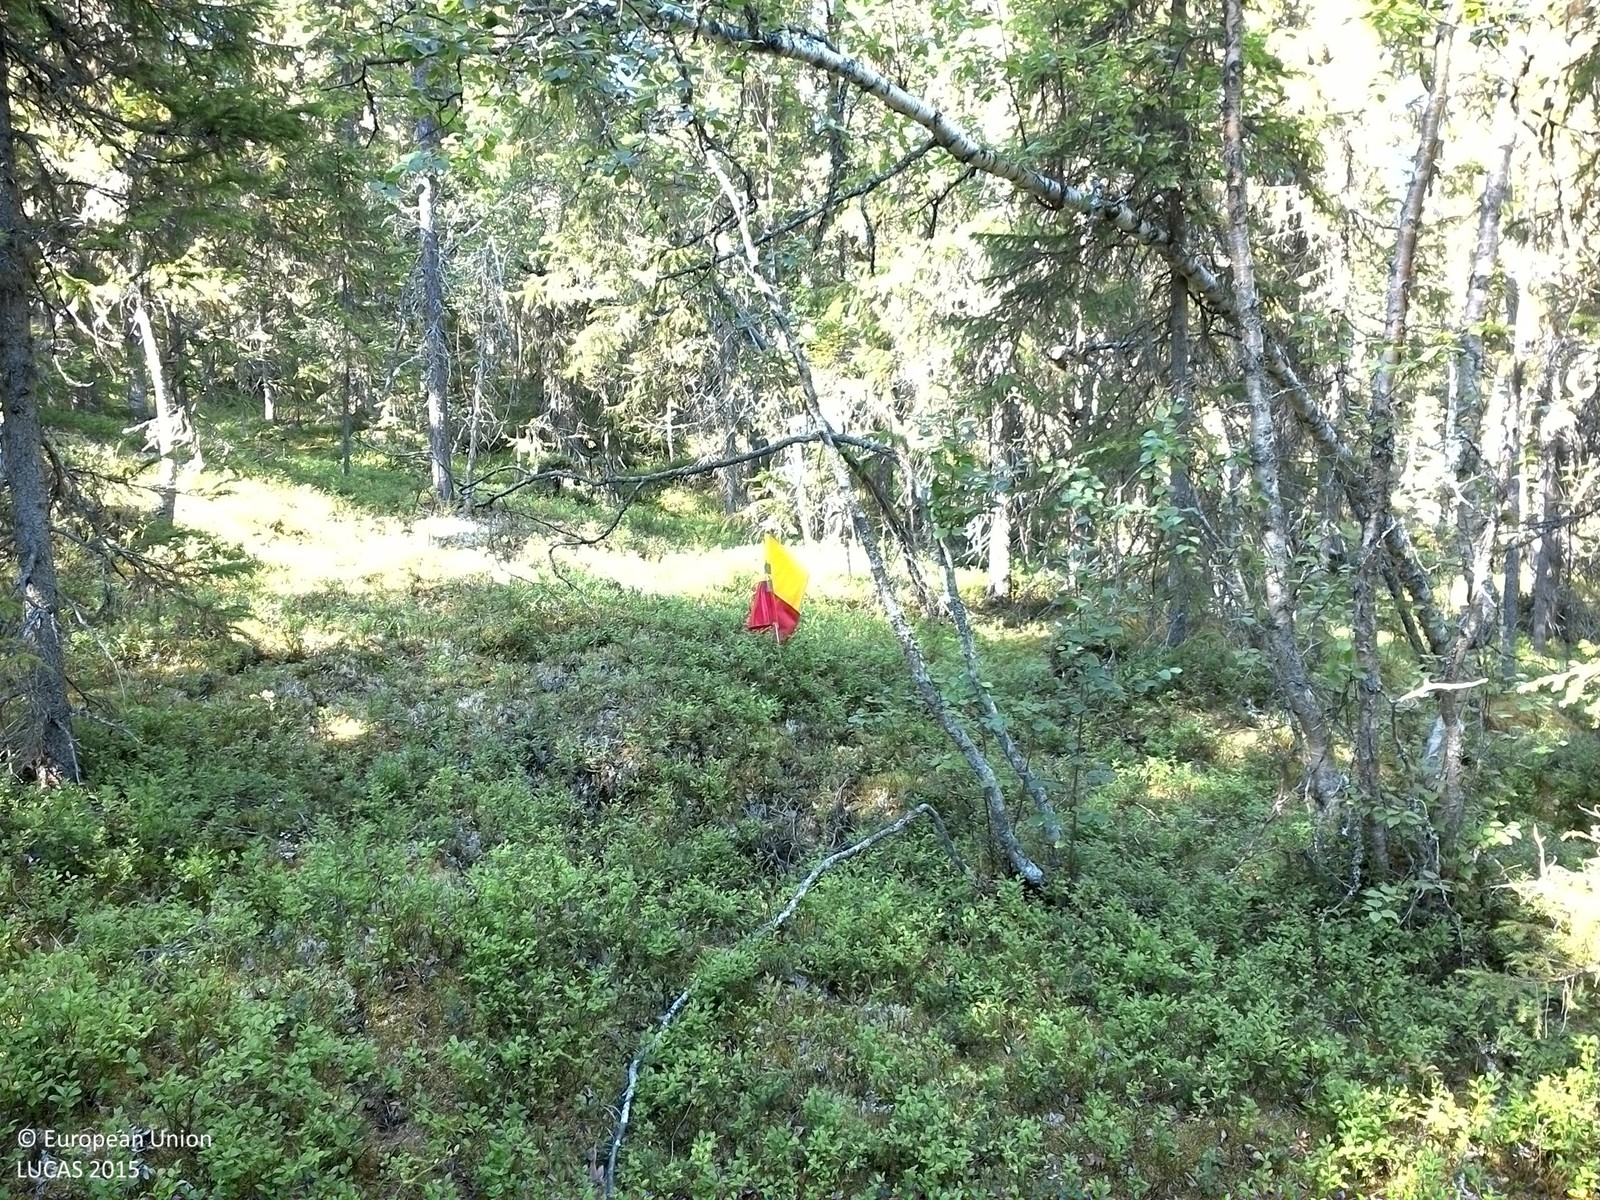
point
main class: Woodland
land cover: Spruce dominated coniferous woodland
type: boreal forest
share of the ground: 50 - 75 %
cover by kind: coniferous forest trees 55 %, shrubs 25 %, broadleaved forest trees 10 %, herbaceous plants 10 %
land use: Forestry
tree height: > 5 m
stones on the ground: < 10 %
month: August
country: SE
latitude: 63.9636
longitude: 16.7705
